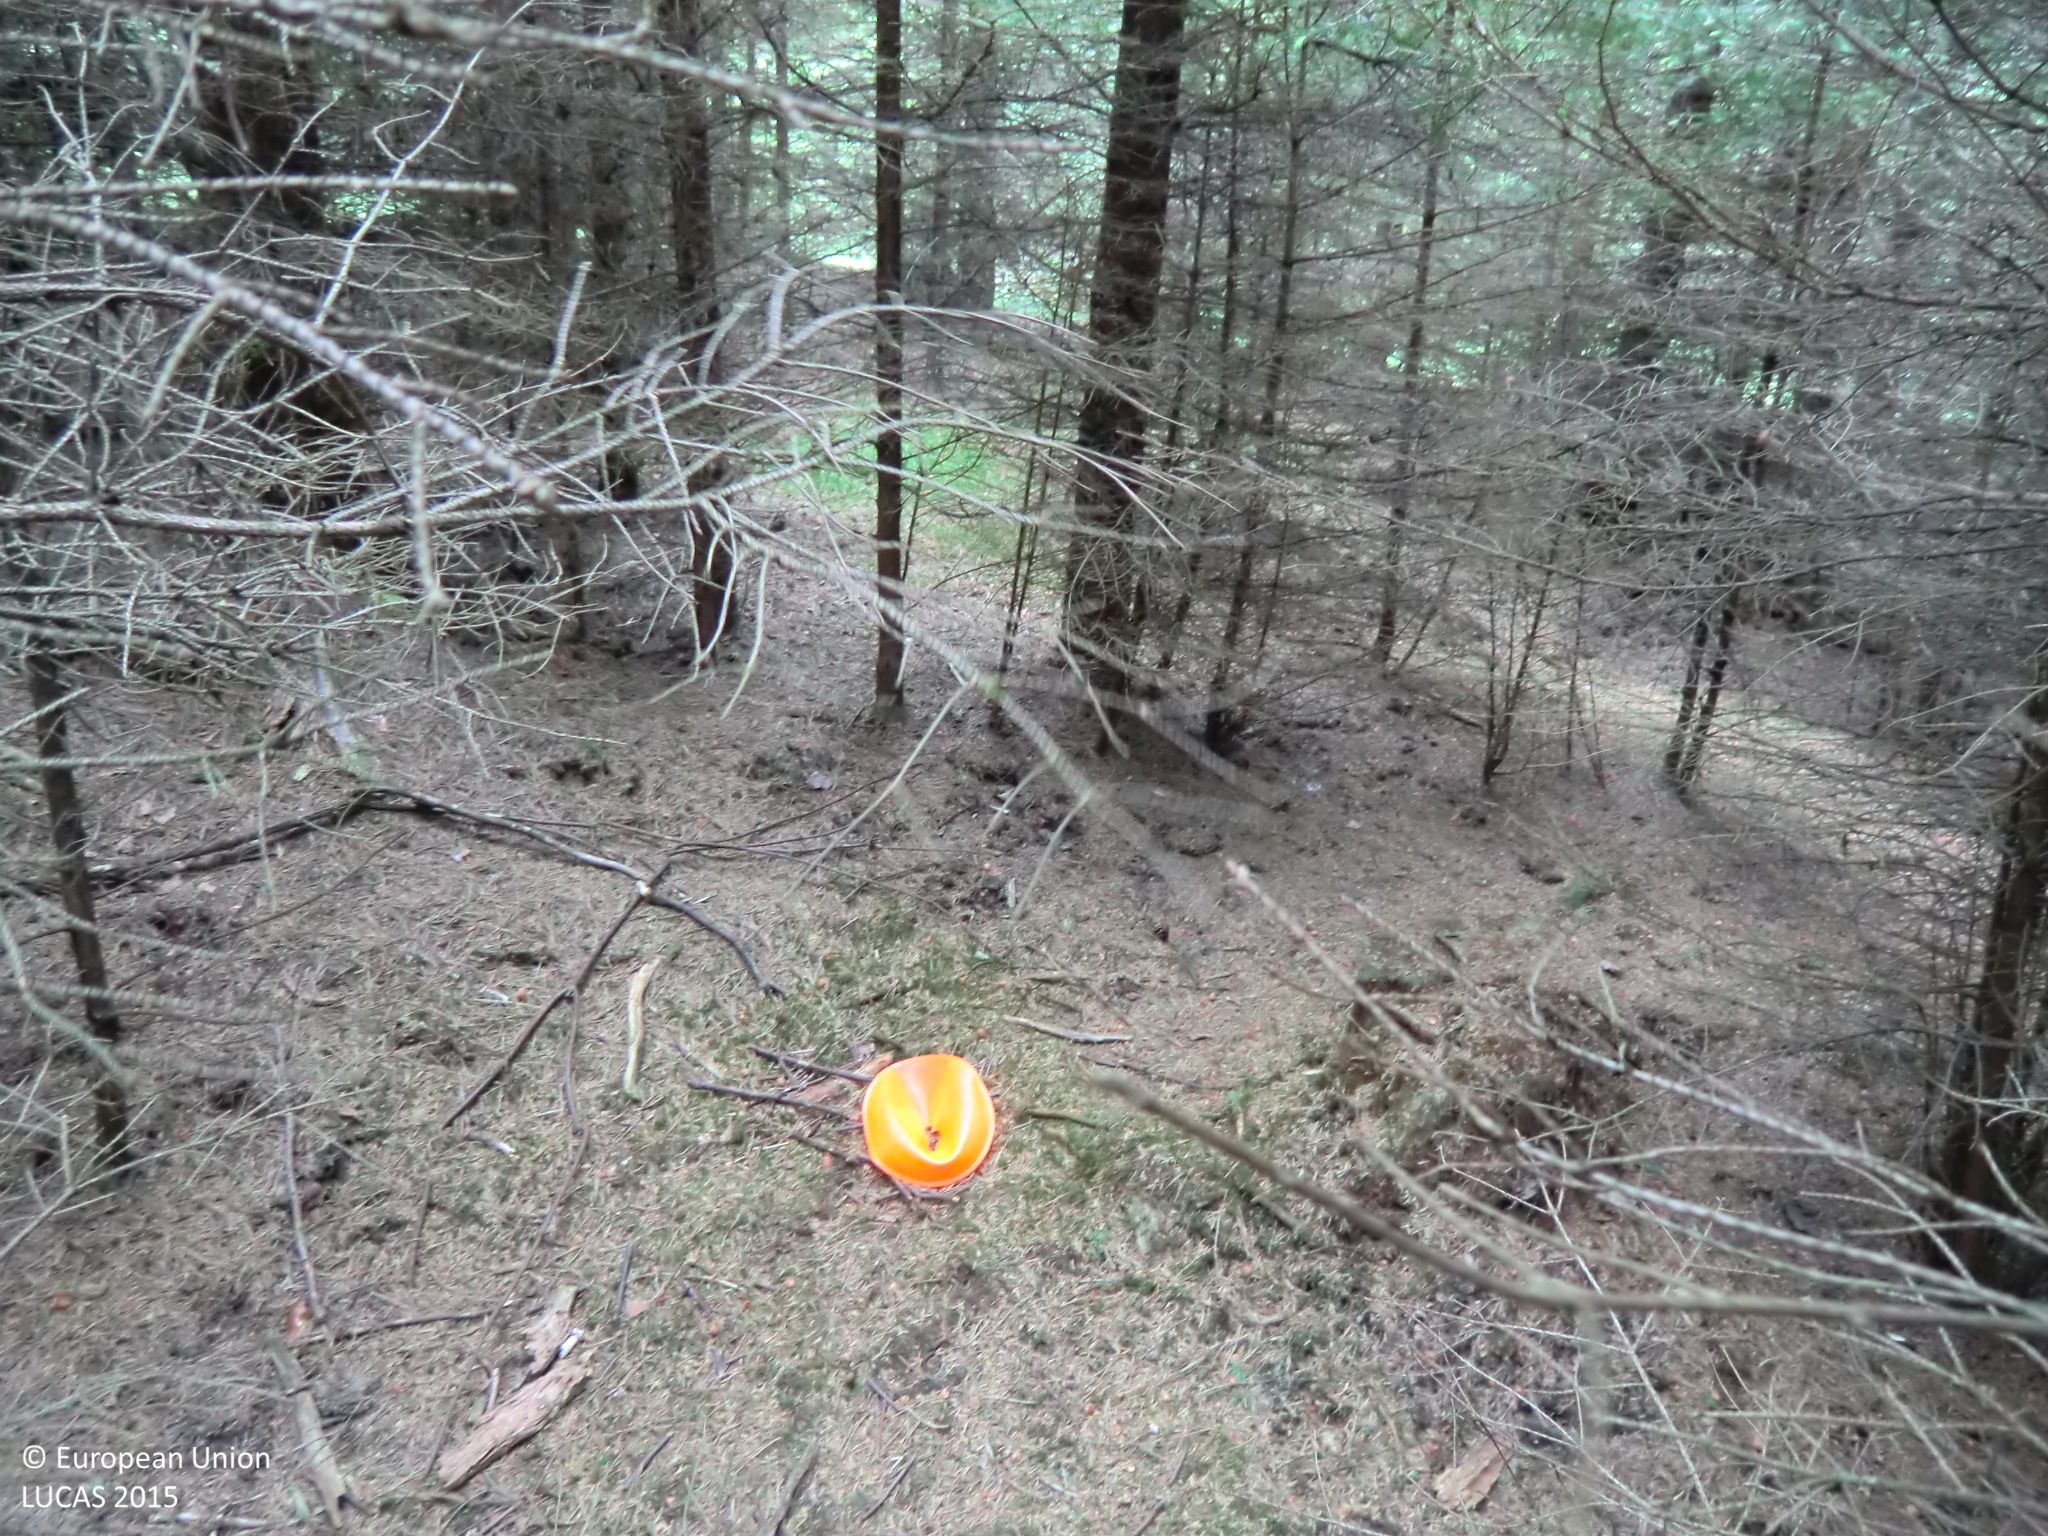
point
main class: Woodland
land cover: Spruce dominated coniferous woodland
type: hemiboreal forest and nemoral coniferous forest and mixed broadleaved-coniferous forest
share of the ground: > 75 %
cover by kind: coniferous forest trees 90 %, unconsolidated bare surface 10 %
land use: Forestry
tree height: > 5 m
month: June
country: AT
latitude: 48.5954
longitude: 15.0322
